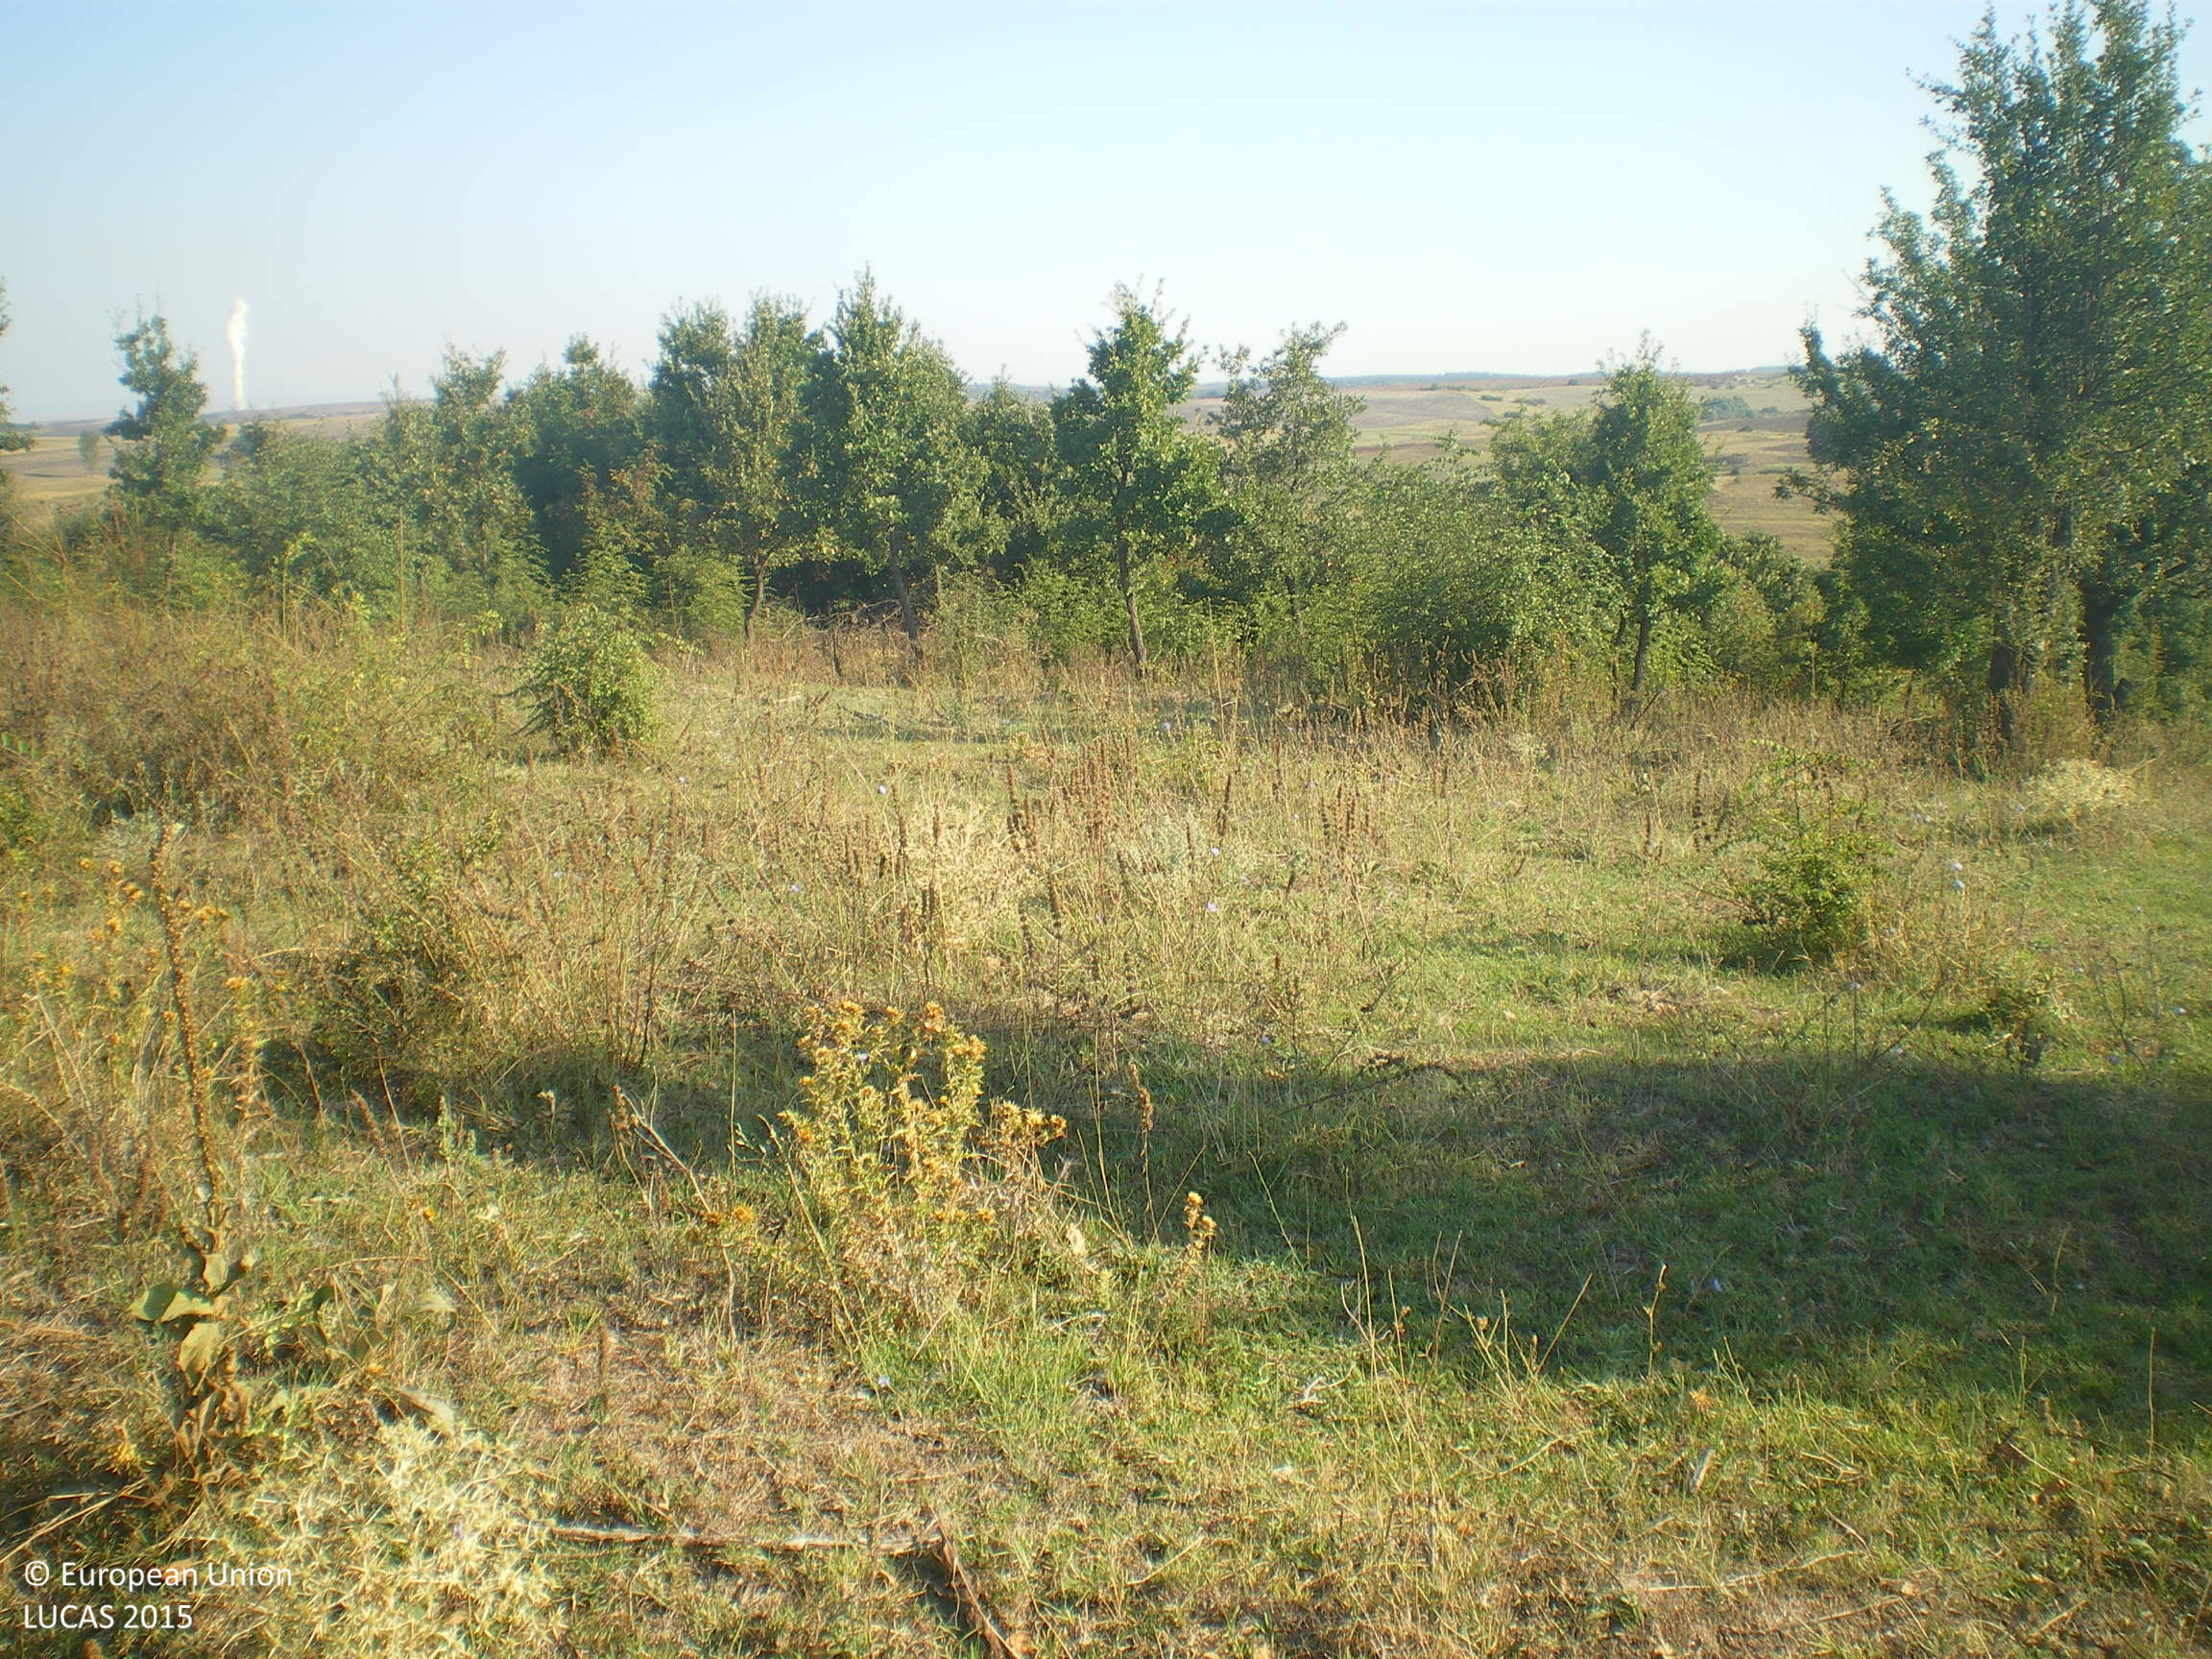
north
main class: Grassland
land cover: Grassland with sparse tree/shrub cover
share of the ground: > 75 %
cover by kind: herbaceous plants 85 %, shrubs 10 %, broadleaved forest trees 5 %
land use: Agriculture (excluding fallow land and kitchen gardens)
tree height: > 5 m
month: August
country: BG
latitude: 42.0619
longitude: 25.9409
